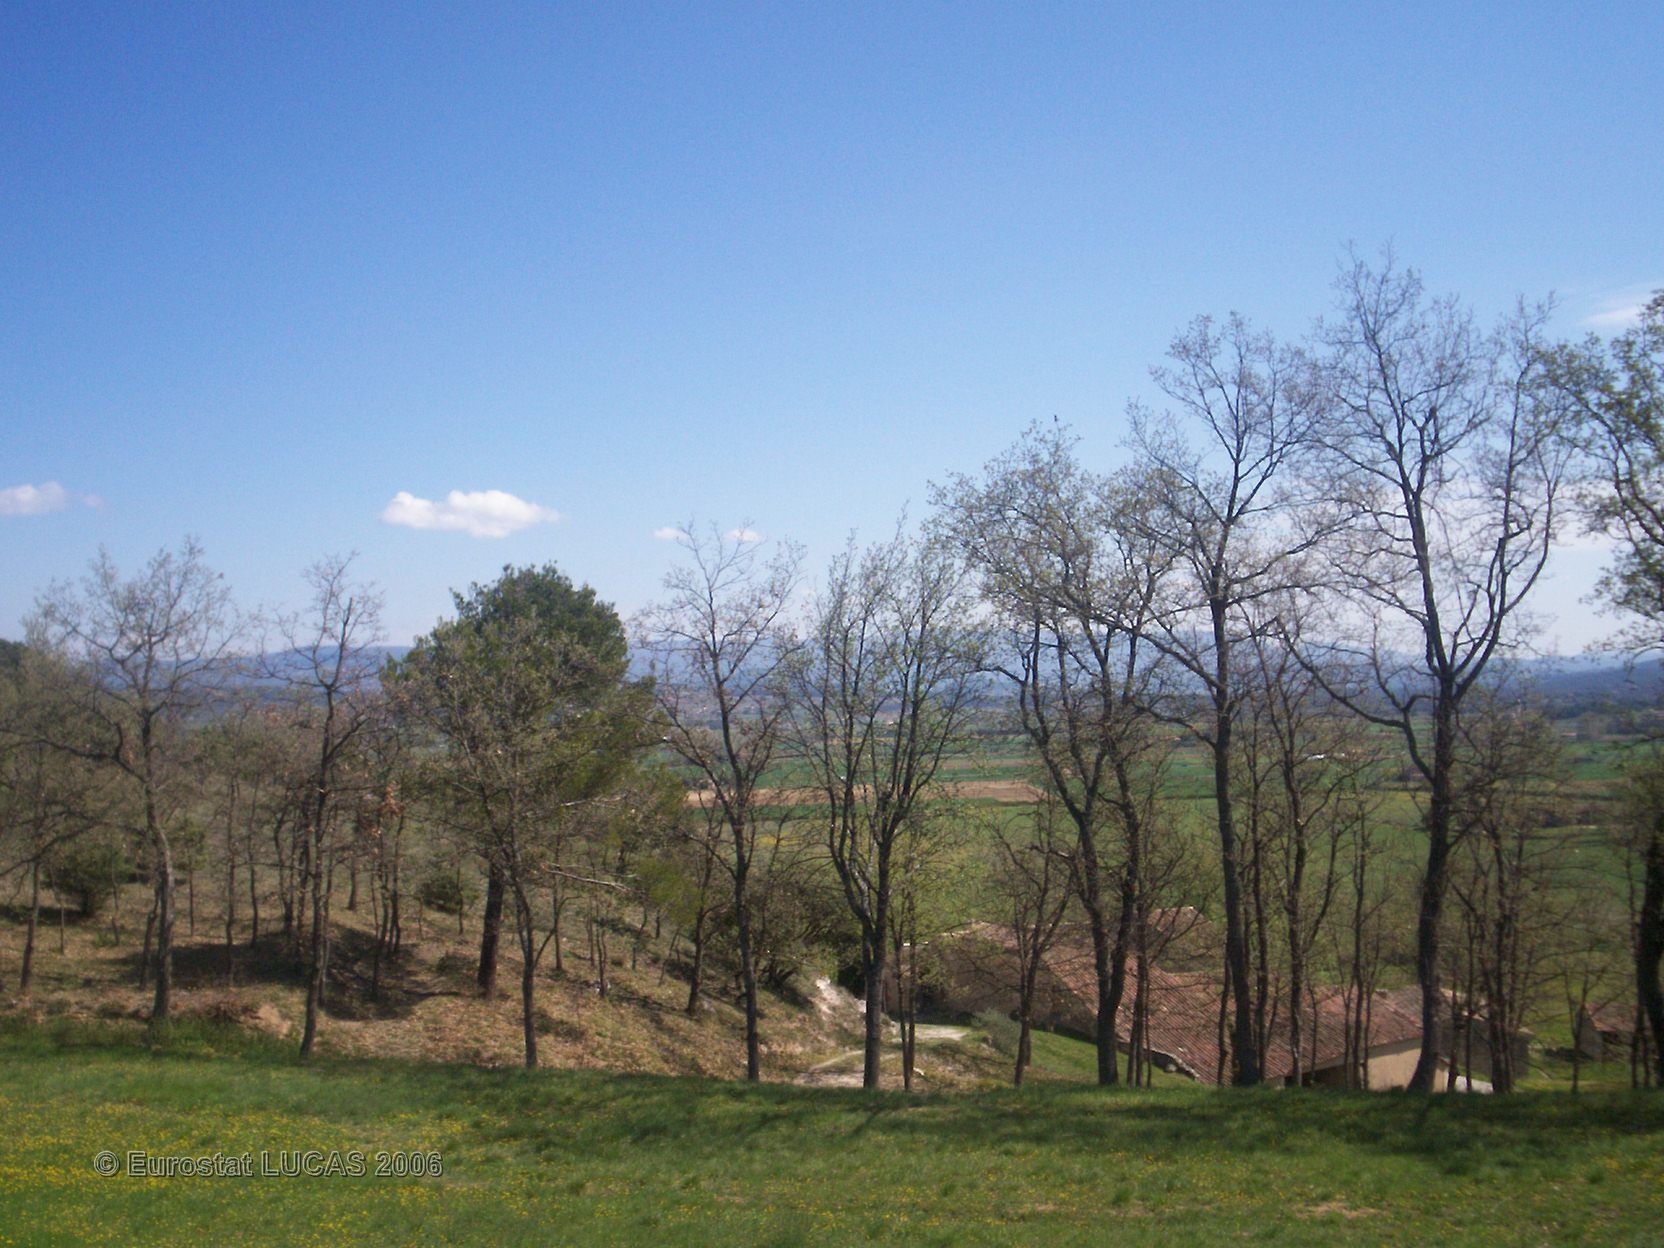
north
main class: Grassland
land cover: Grassland without tree/shrub cover
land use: Agriculture (excluding fallow land and kitchen gardens)
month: April
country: FR
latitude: 43.8452
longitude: 5.2697
